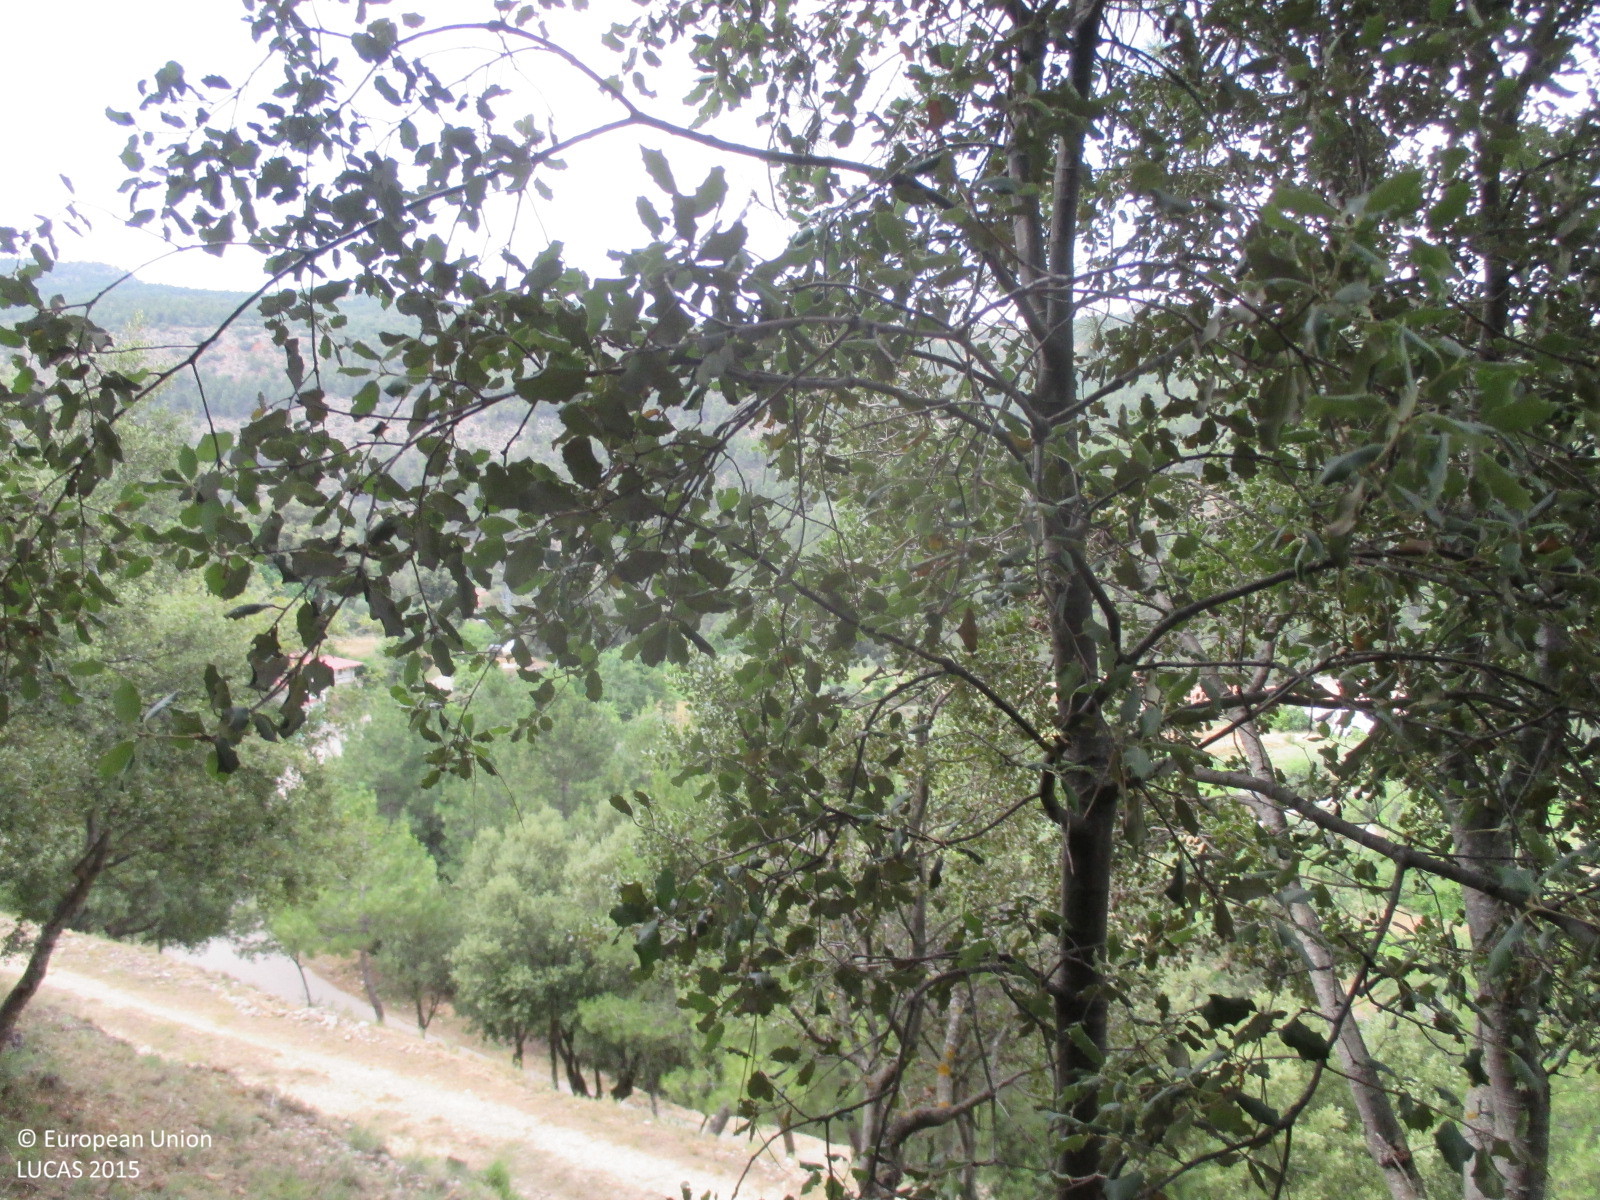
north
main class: Woodland
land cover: Broadleaved woodland
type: broadleaved evergreen forest
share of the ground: > 75 %
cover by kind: broadleaved forest trees 95 %, coniferous forest trees 5 %
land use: Forestry
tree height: > 5 m
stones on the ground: < 10 %
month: July
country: ES
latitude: 38.1870
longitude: -2.4735
